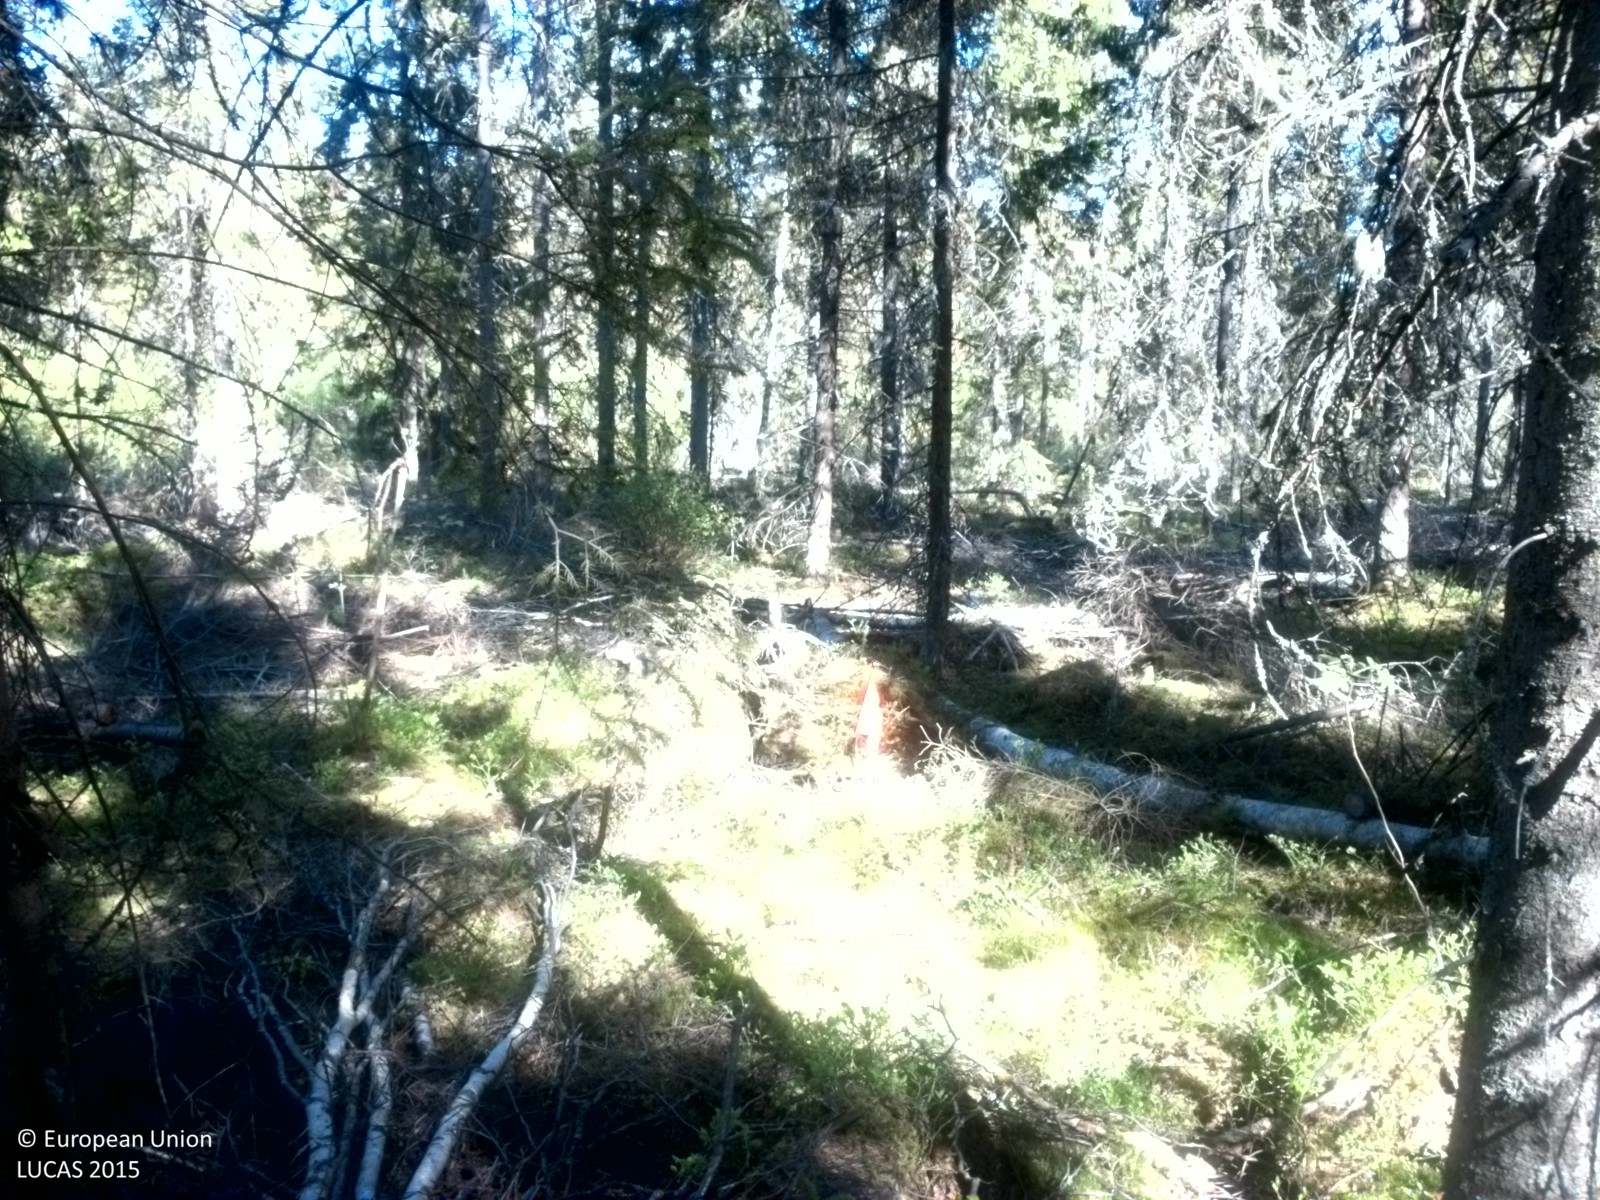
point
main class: Woodland
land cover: Spruce dominated coniferous woodland
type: boreal forest
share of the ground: > 75 %
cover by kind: coniferous forest trees 75 %, lichens and mosses 25 %
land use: Forestry
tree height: > 5 m
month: June
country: SE
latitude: 63.7348
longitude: 20.2922
